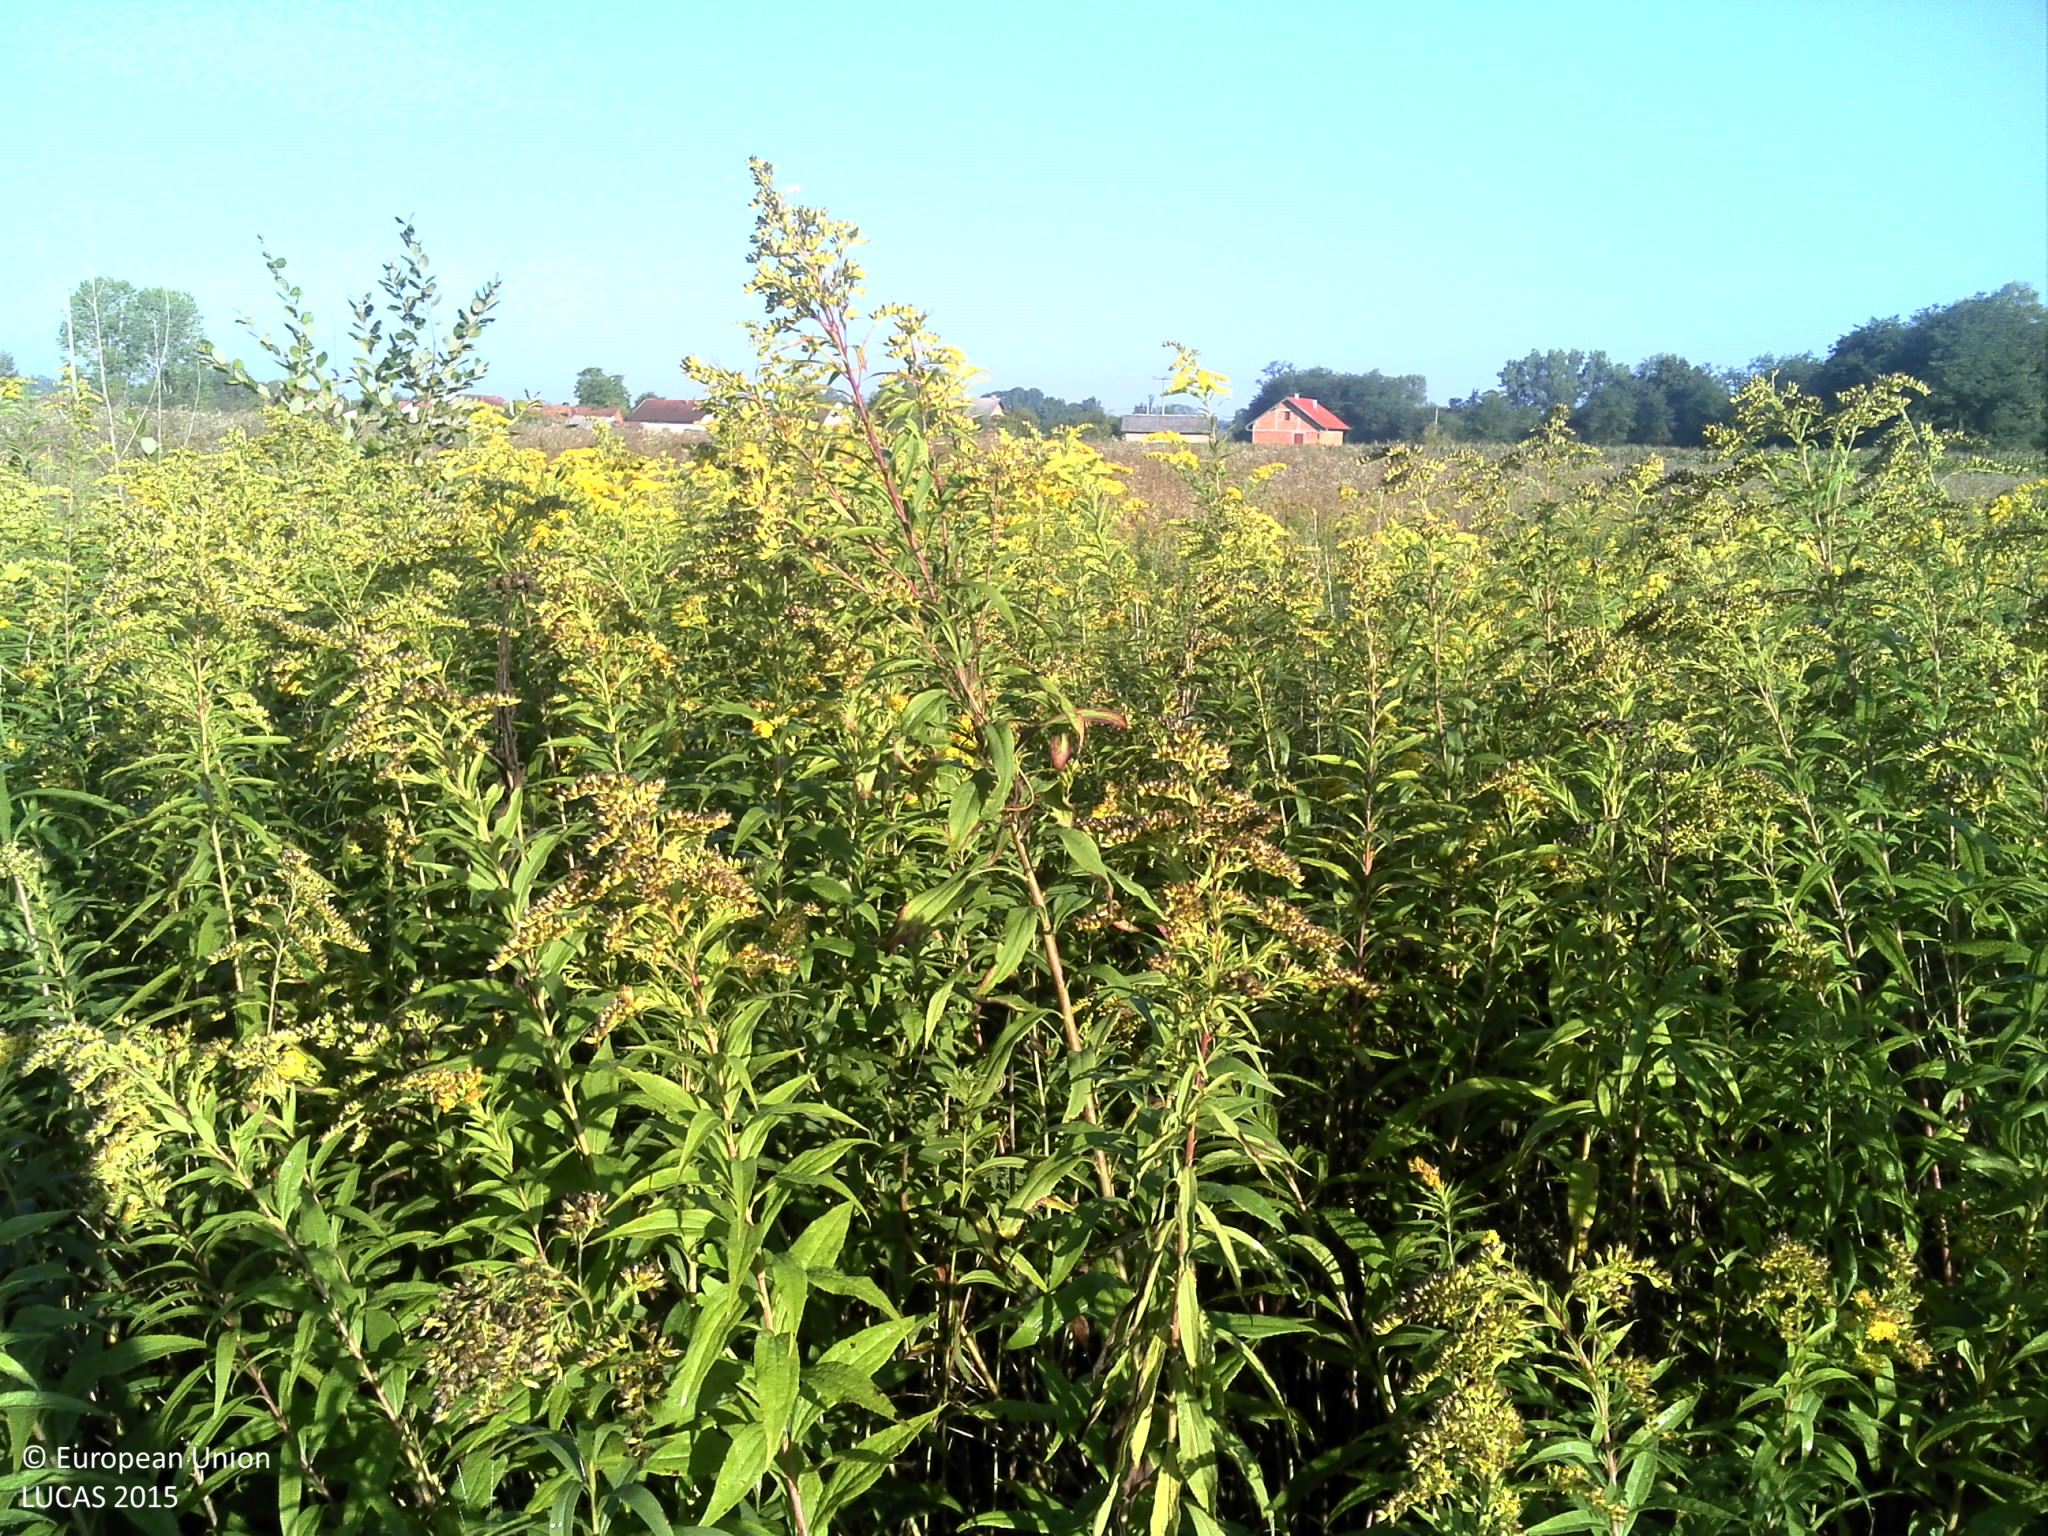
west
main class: Grassland
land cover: Spontaneously vegetated surfaces
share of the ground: > 75 %
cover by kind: herbaceous plants 100 %
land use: Fallow land
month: August
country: HR
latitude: 45.3275
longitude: 16.1082
